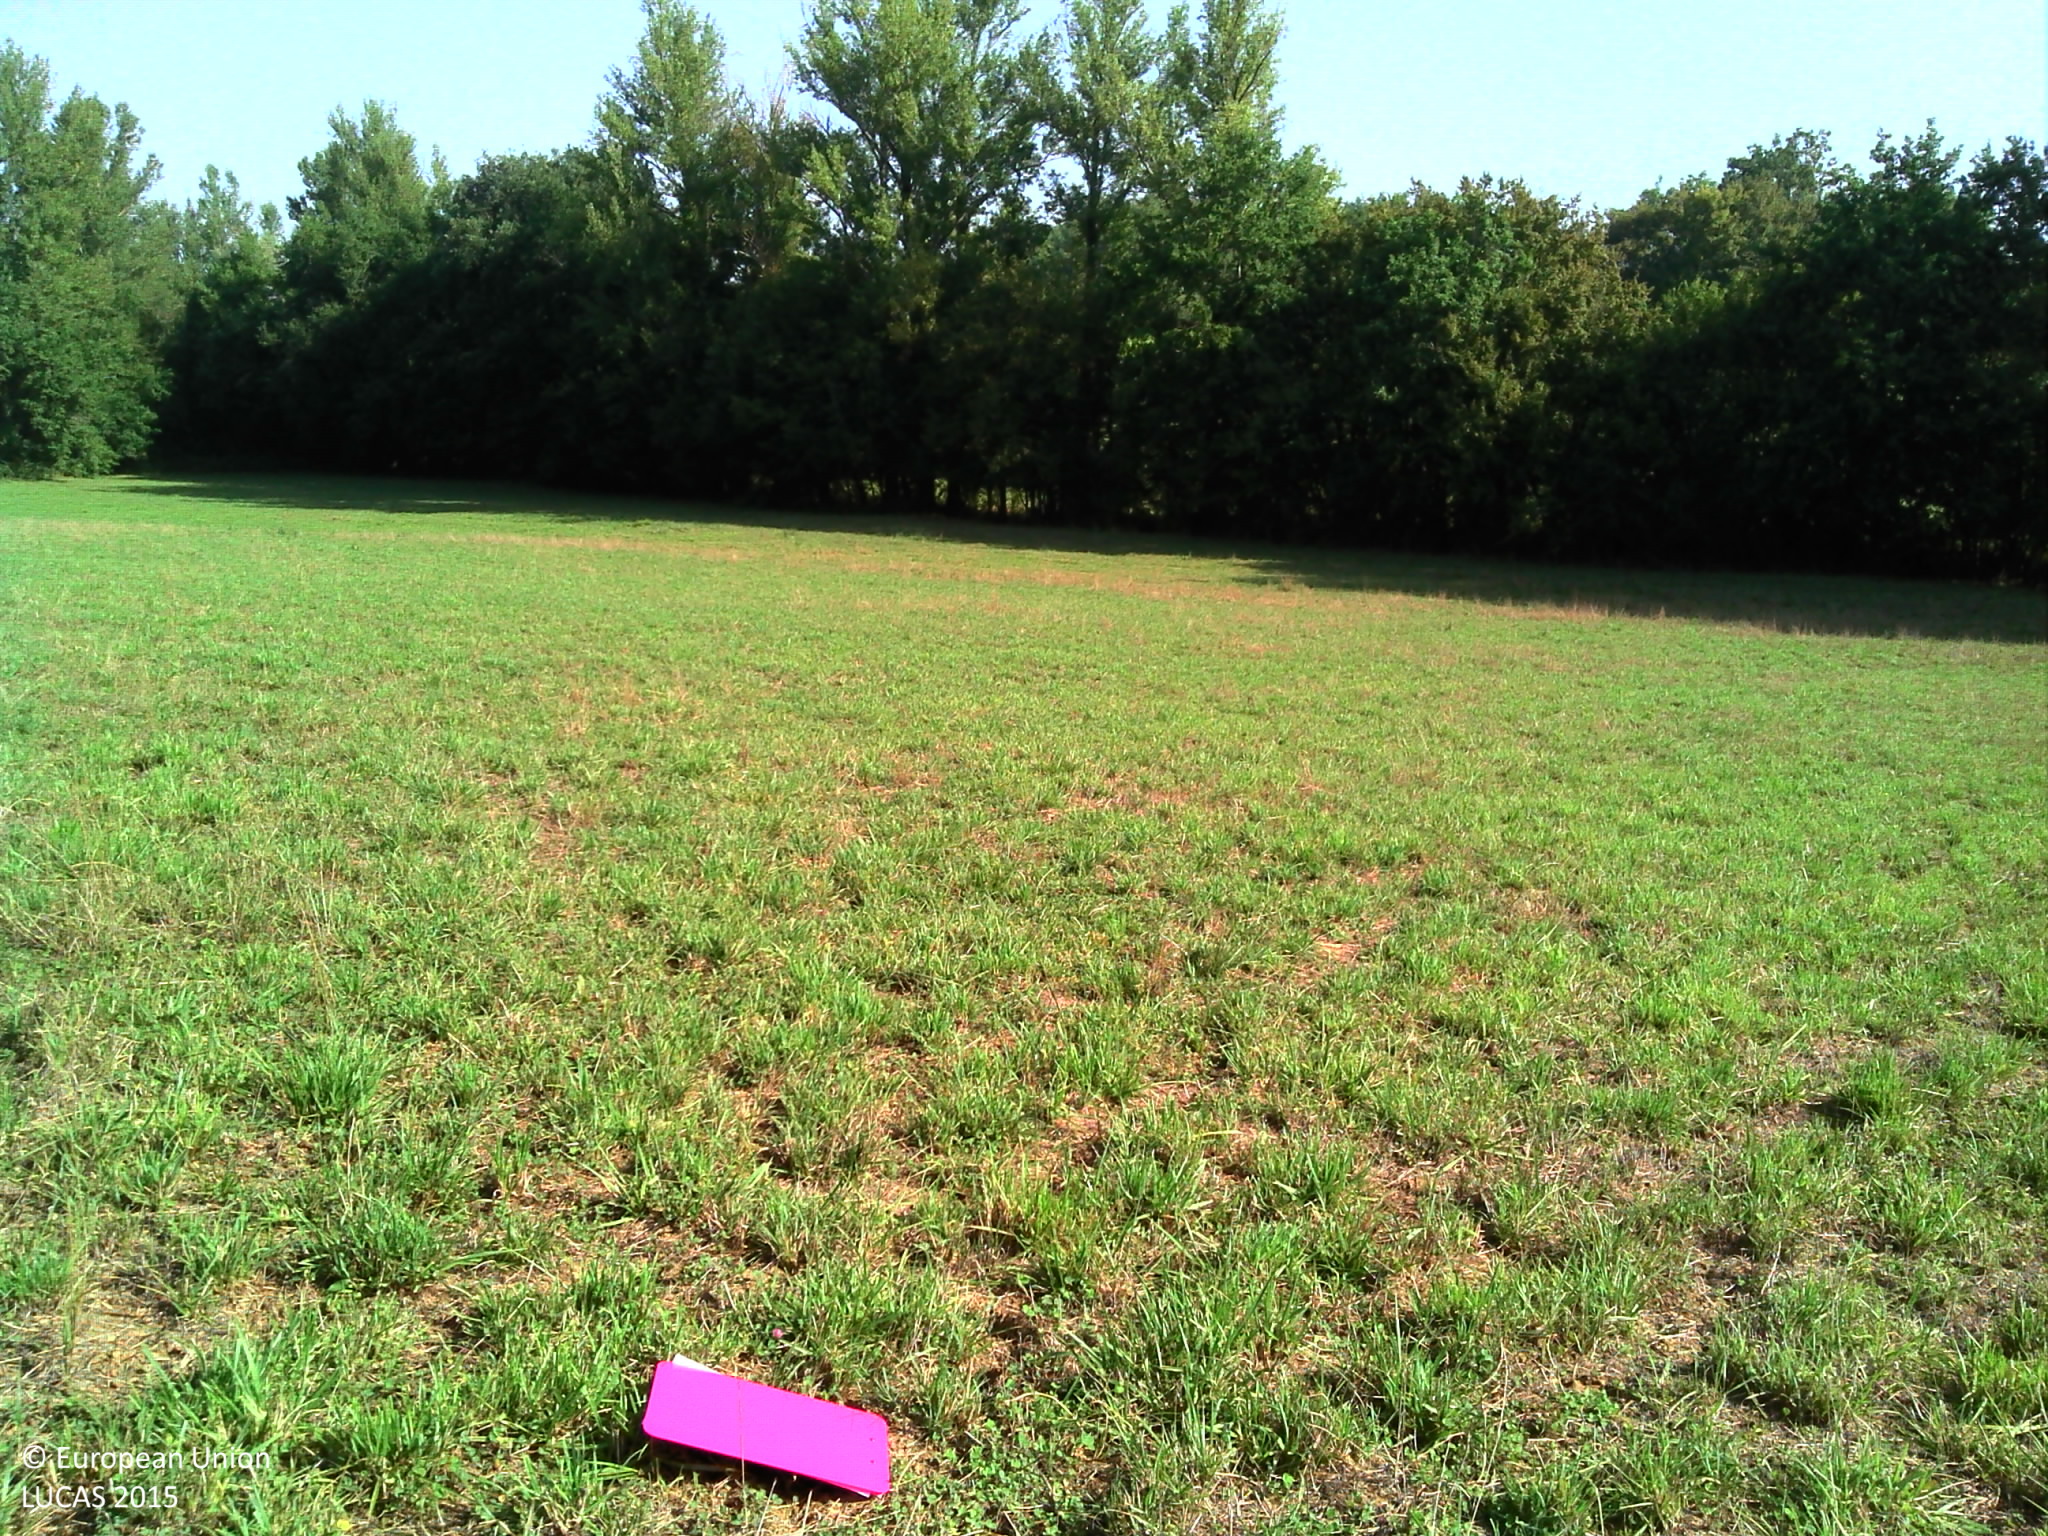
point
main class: Grassland
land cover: Grassland without tree/shrub cover
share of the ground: > 75 %
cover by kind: herbaceous plants 100 %
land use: Agriculture (excluding fallow land and kitchen gardens)
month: August
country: FR
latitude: 44.1294
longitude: 1.5139
